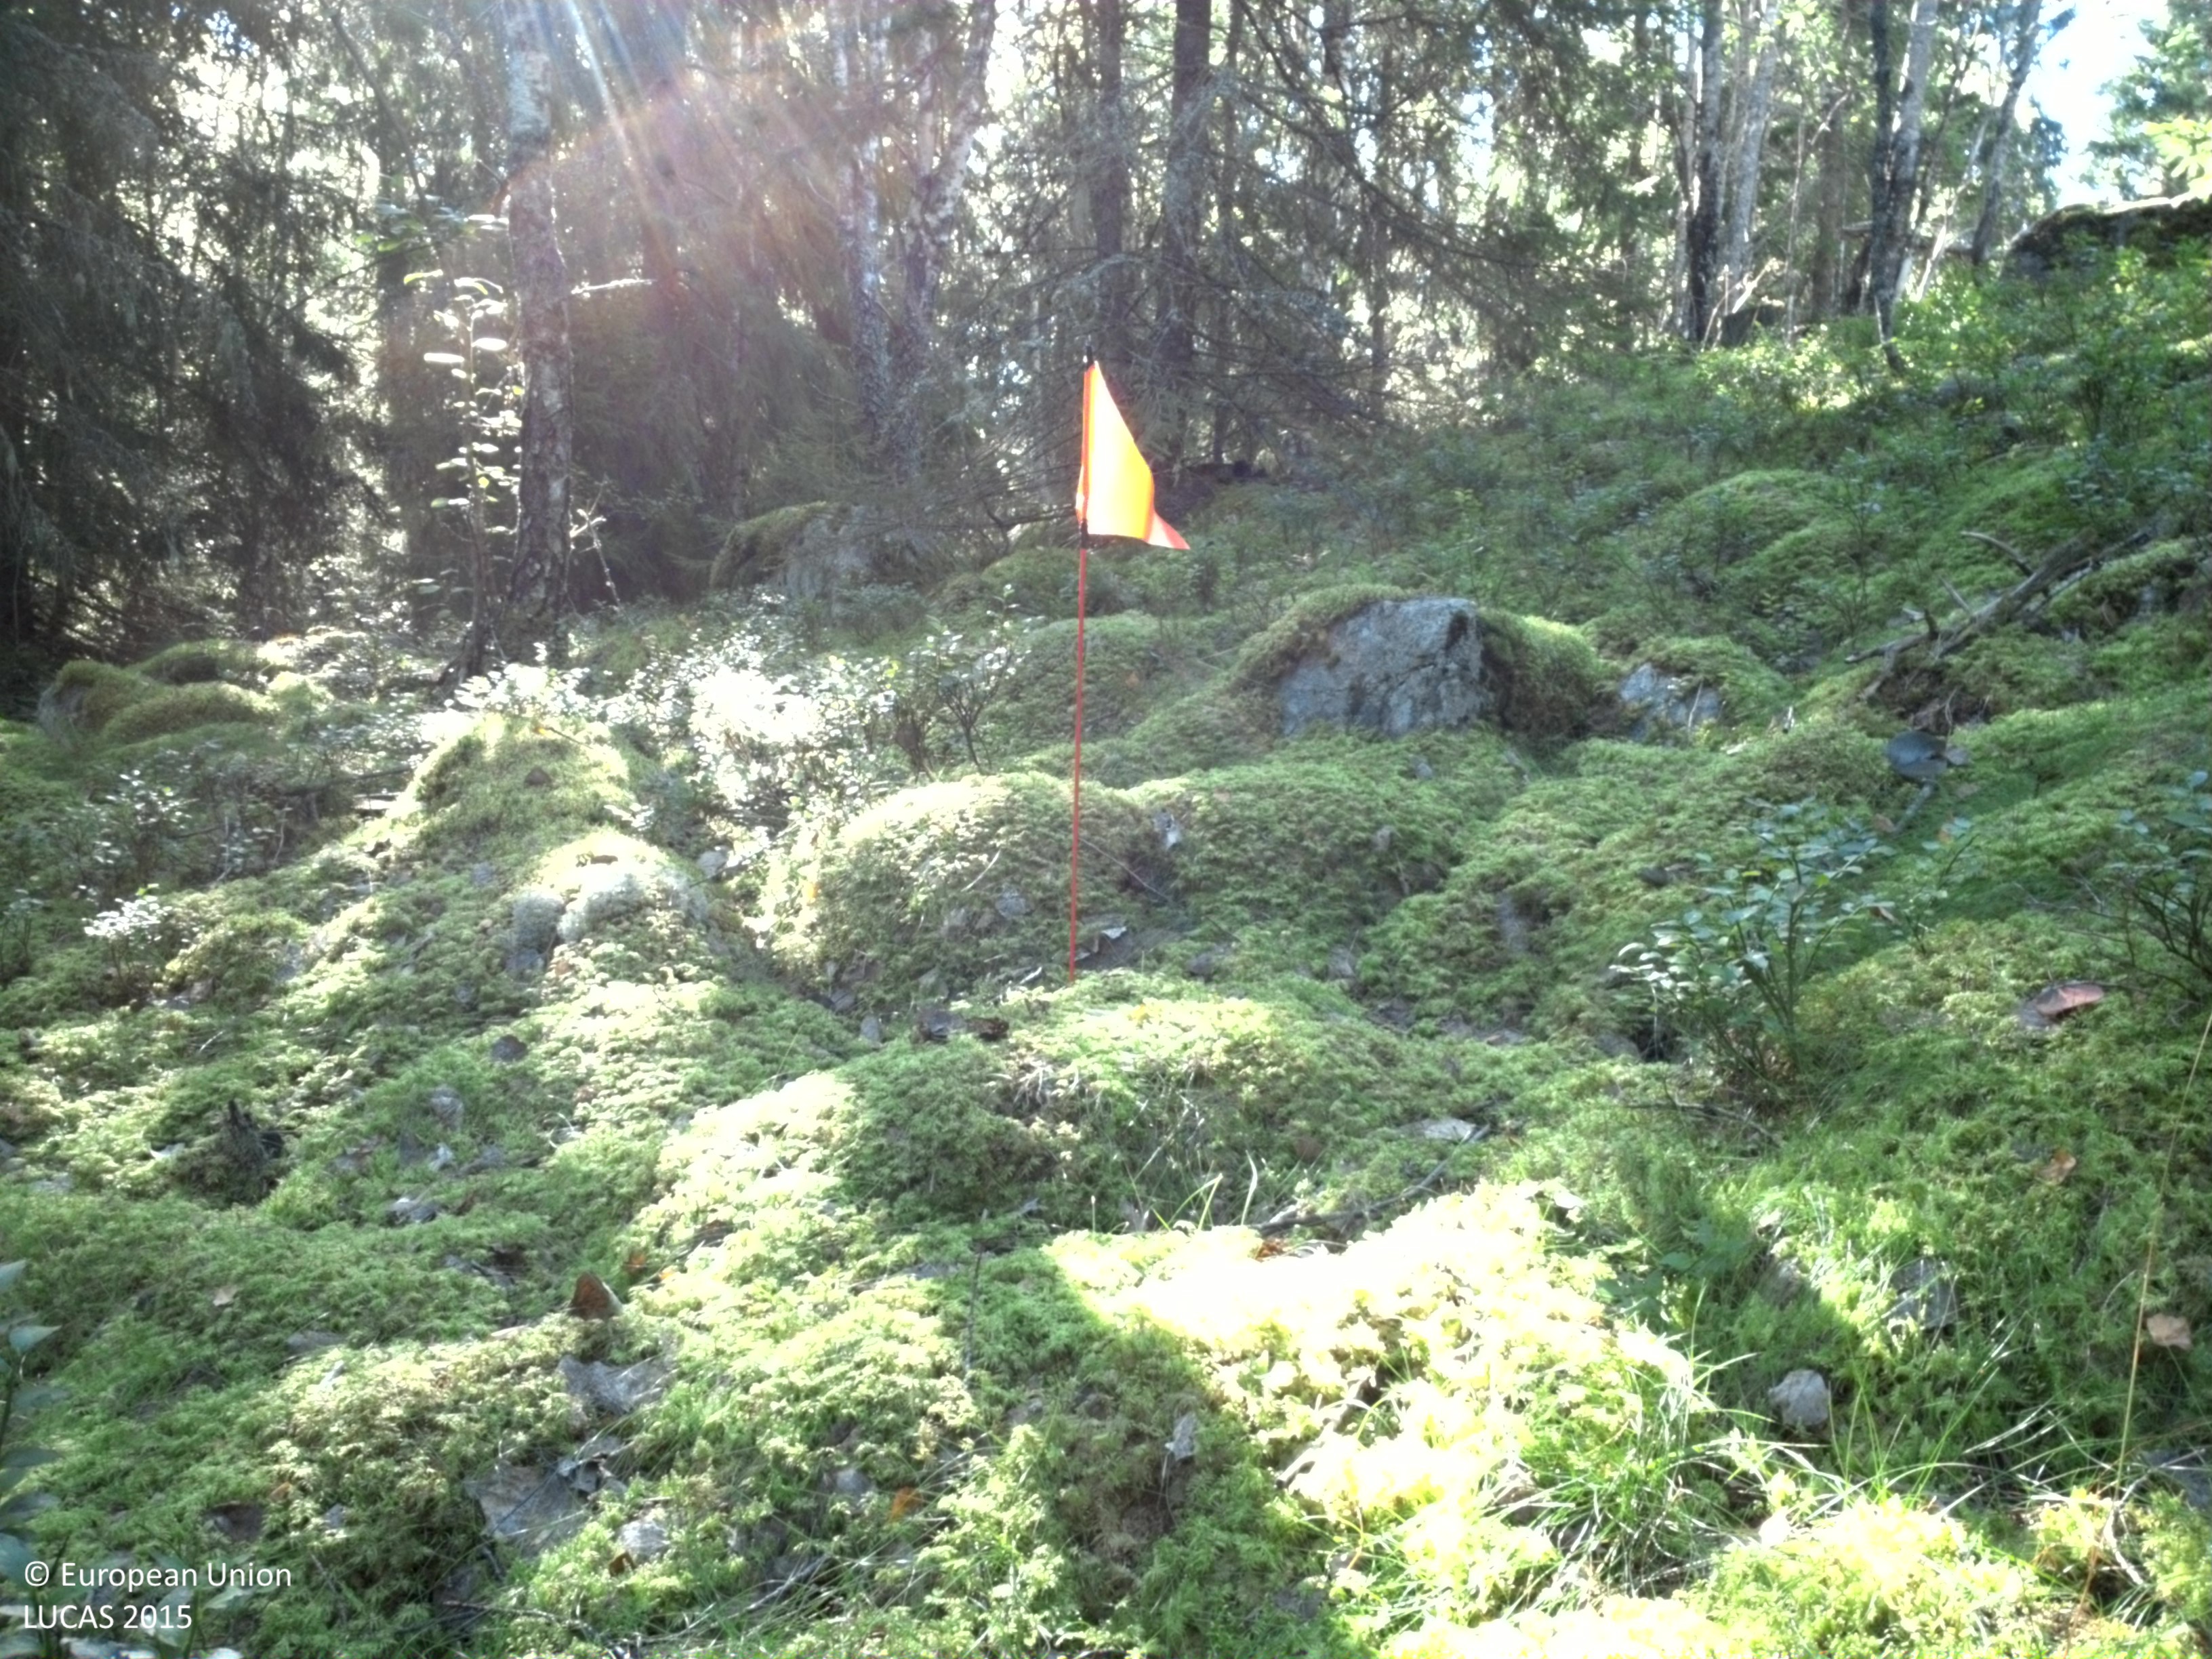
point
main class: Woodland
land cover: Spruce dominated mixed woodland
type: boreal forest
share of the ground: 50 - 75 %
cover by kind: coniferous forest trees 50 %, lichens and mosses 30 %, broadleaved forest trees 20 %
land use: Forestry
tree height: > 5 m
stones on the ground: 10 - 25 %
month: August
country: SE
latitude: 59.7812
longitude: 17.1716
